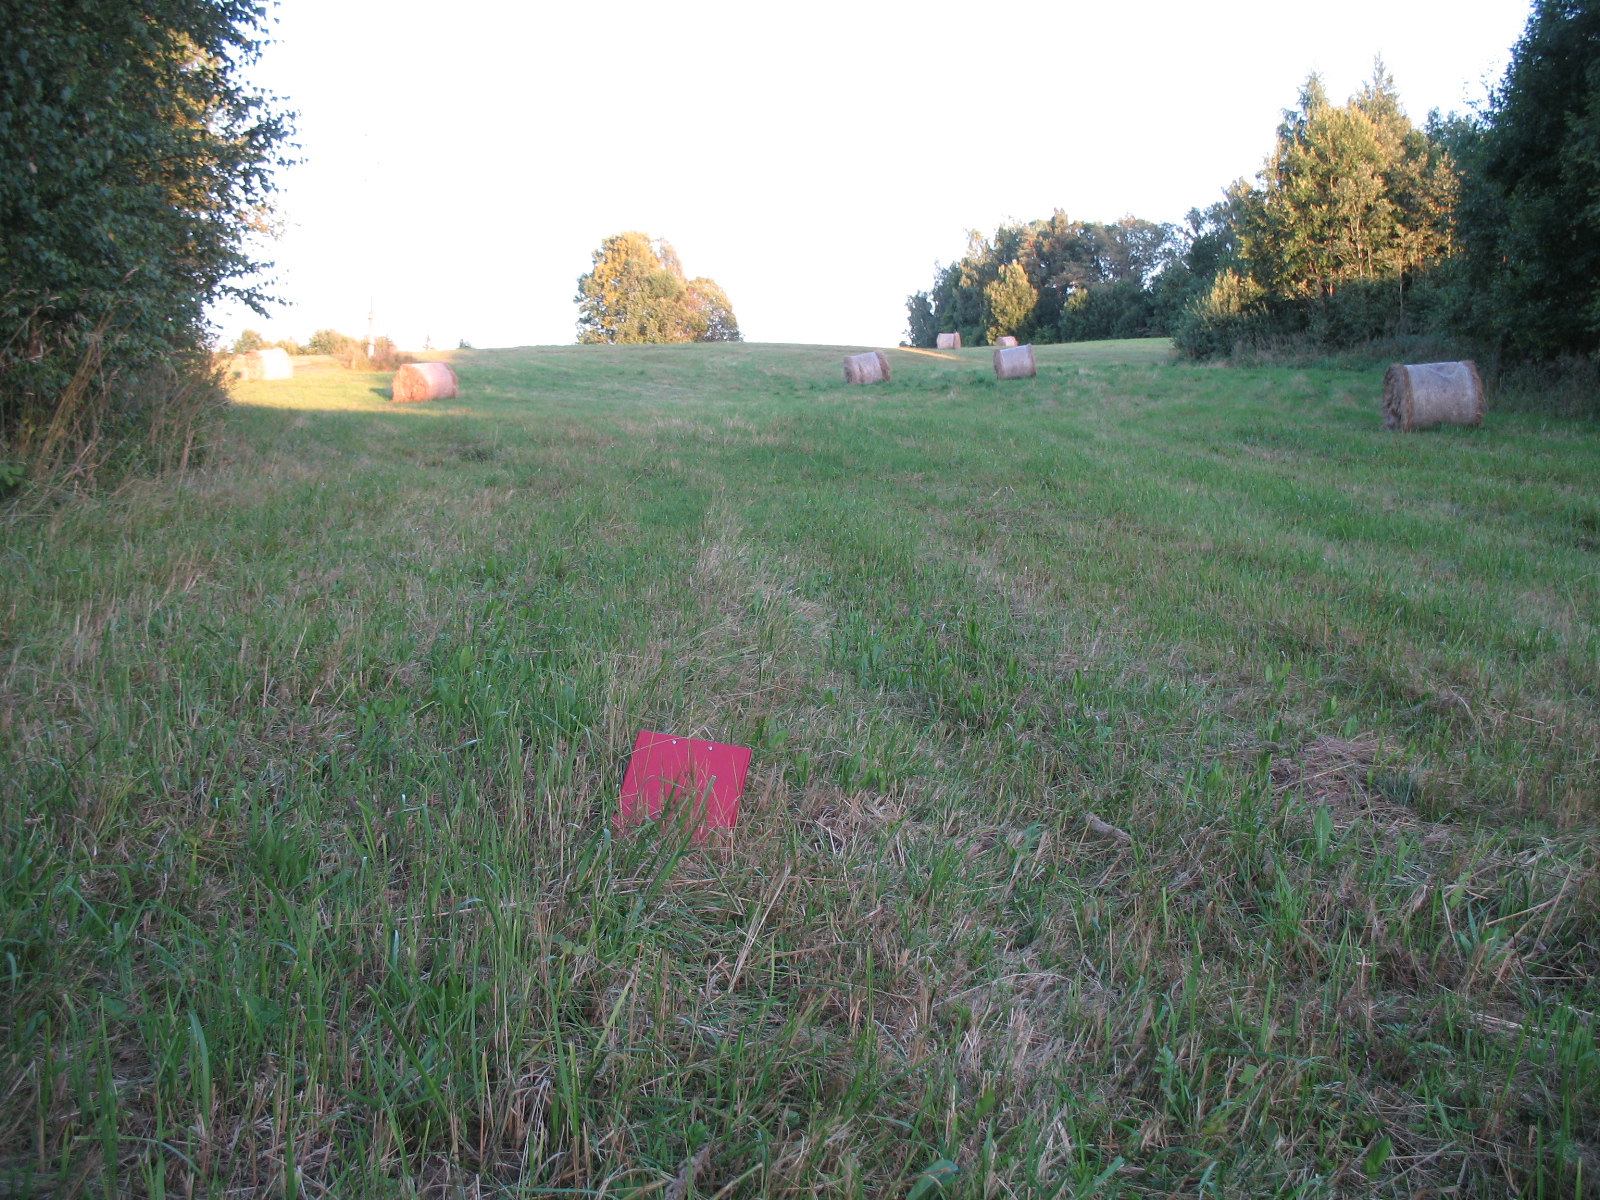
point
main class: Grassland
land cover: Grassland without tree/shrub cover
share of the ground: > 75 %
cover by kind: herbaceous plants 95 %, unconsolidated bare surface 5 %
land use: Agriculture (excluding fallow land and kitchen gardens)
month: August
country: LV
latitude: 56.5925
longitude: 25.6765
